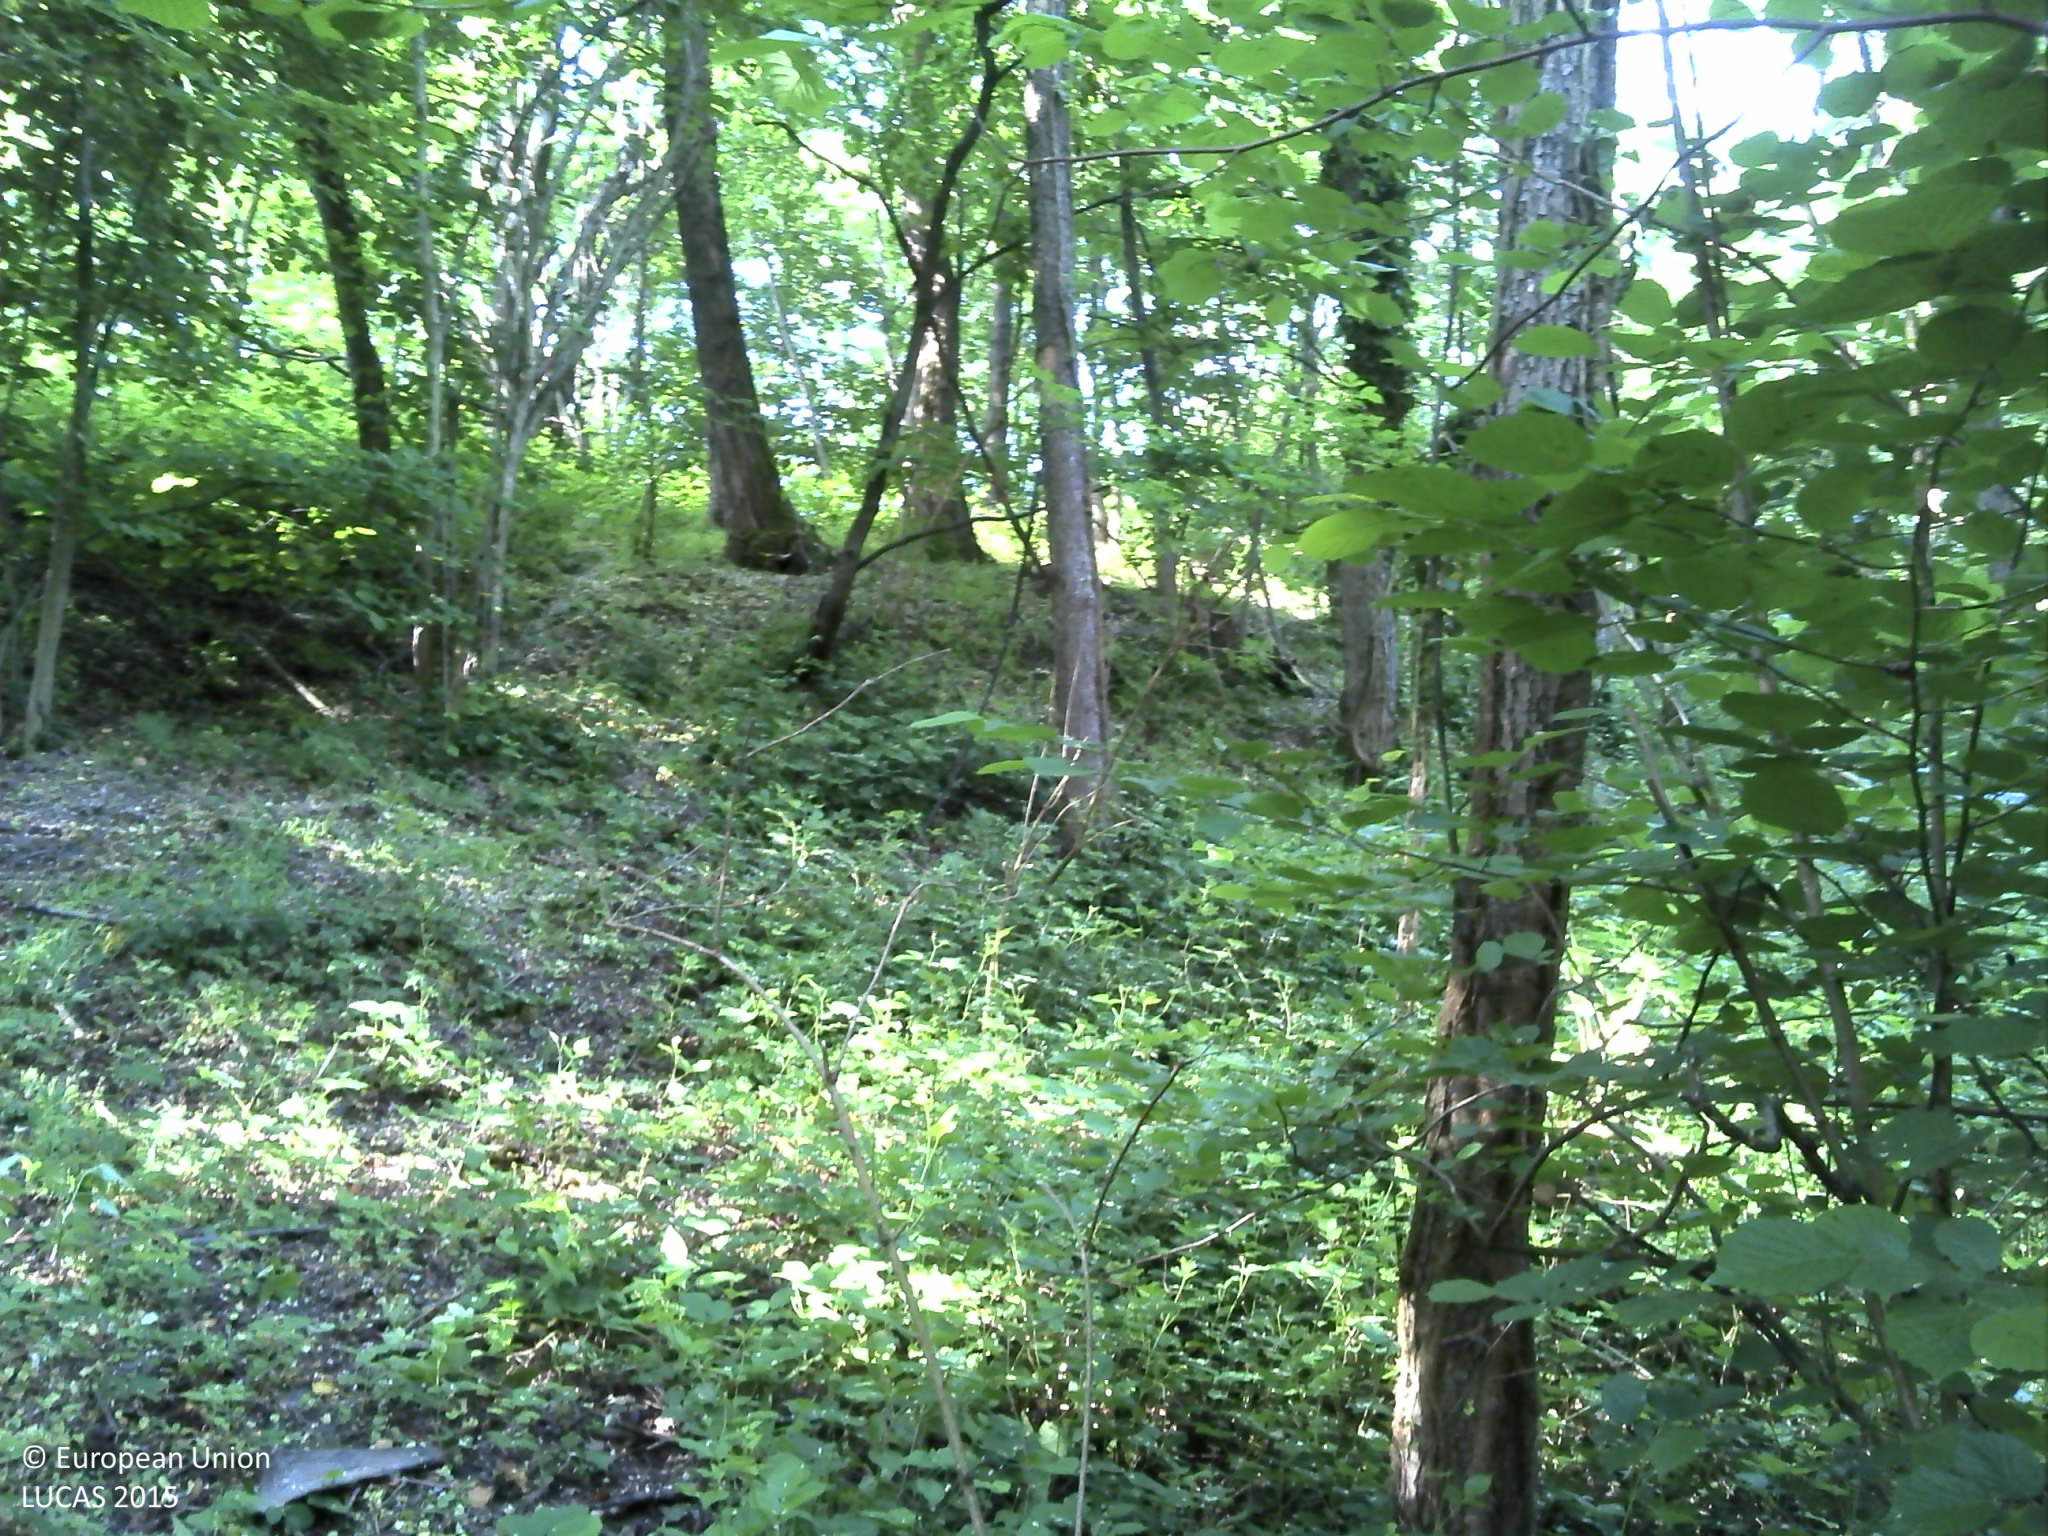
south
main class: Woodland
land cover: Broadleaved woodland
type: mesophytic deciduous forest
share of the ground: > 75 %
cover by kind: broadleaved forest trees 100 %
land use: Forestry
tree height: > 5 m
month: May
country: HR
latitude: 45.4939
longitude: 17.9500
